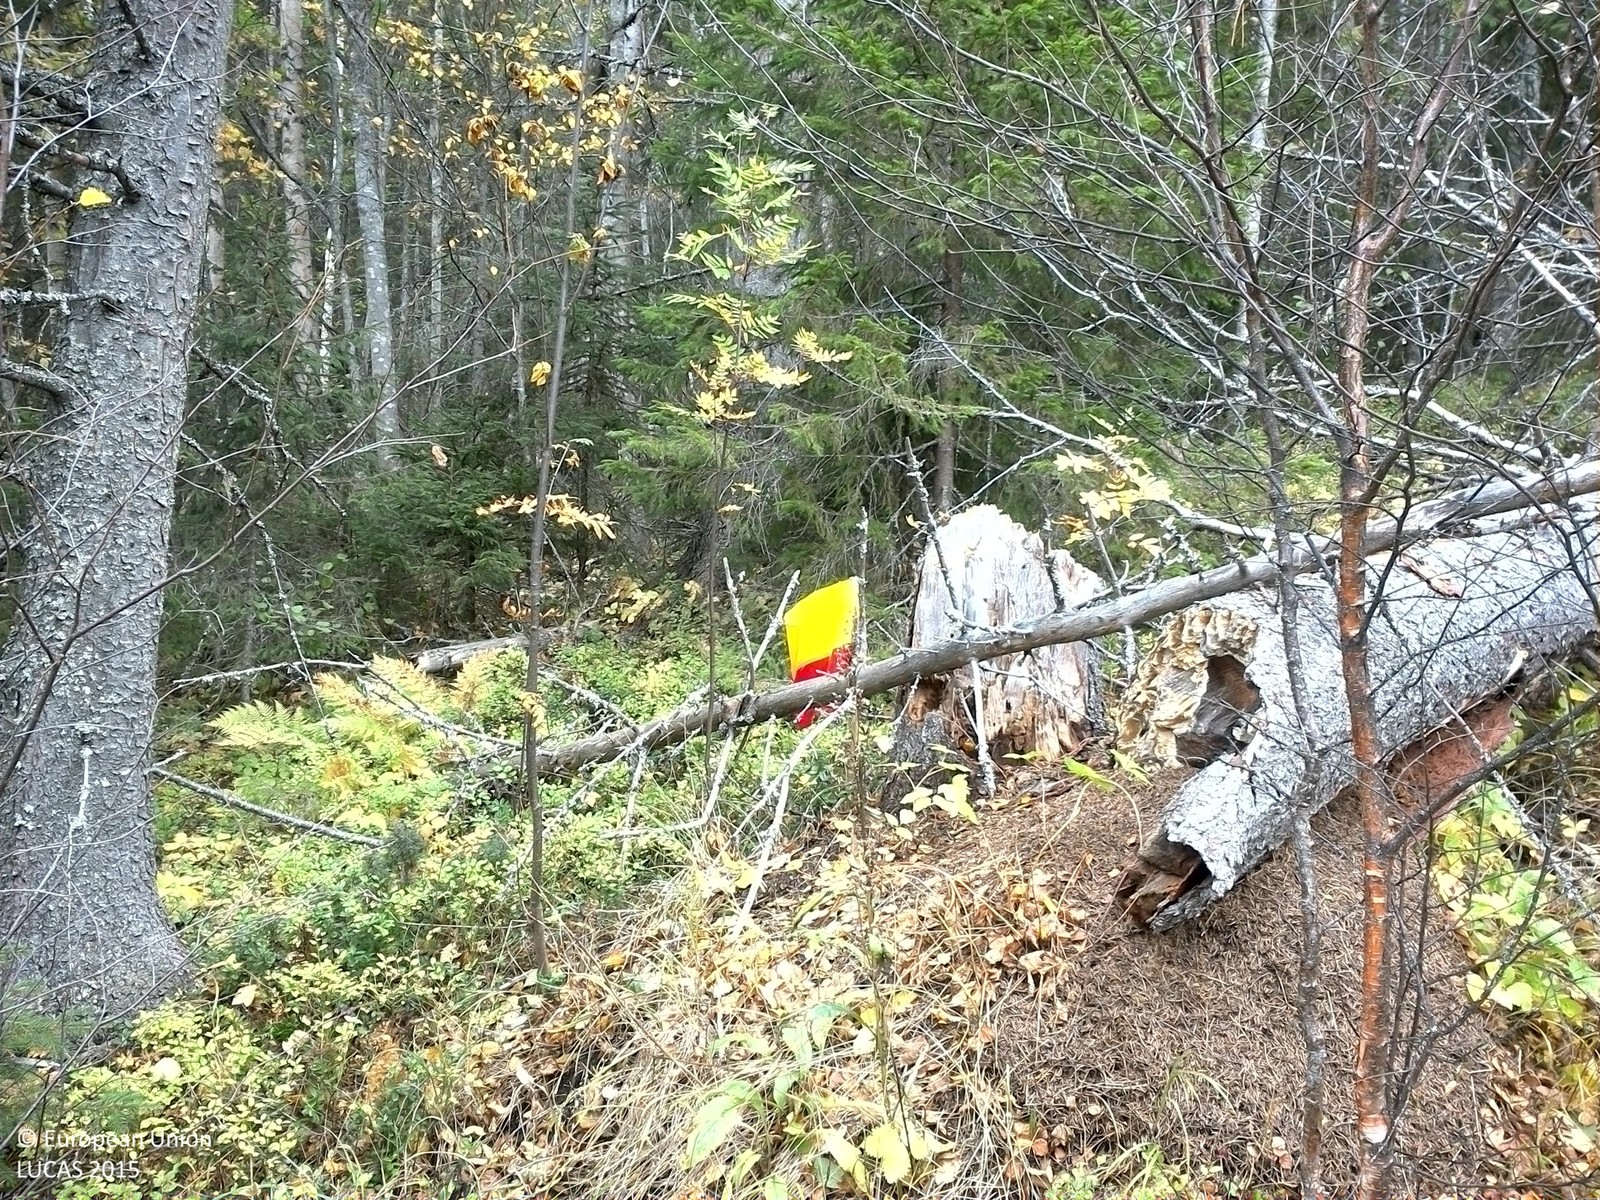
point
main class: Woodland
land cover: Spruce dominated mixed woodland
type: boreal forest
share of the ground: 50 - 75 %
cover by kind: coniferous forest trees 40 %, broadleaved forest trees 25 %, shrubs 20 %, lichens and mosses 10 %, herbaceous plants 5 %
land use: Forestry
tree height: > 5 m
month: October
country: SE
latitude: 64.2151
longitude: 15.9252
